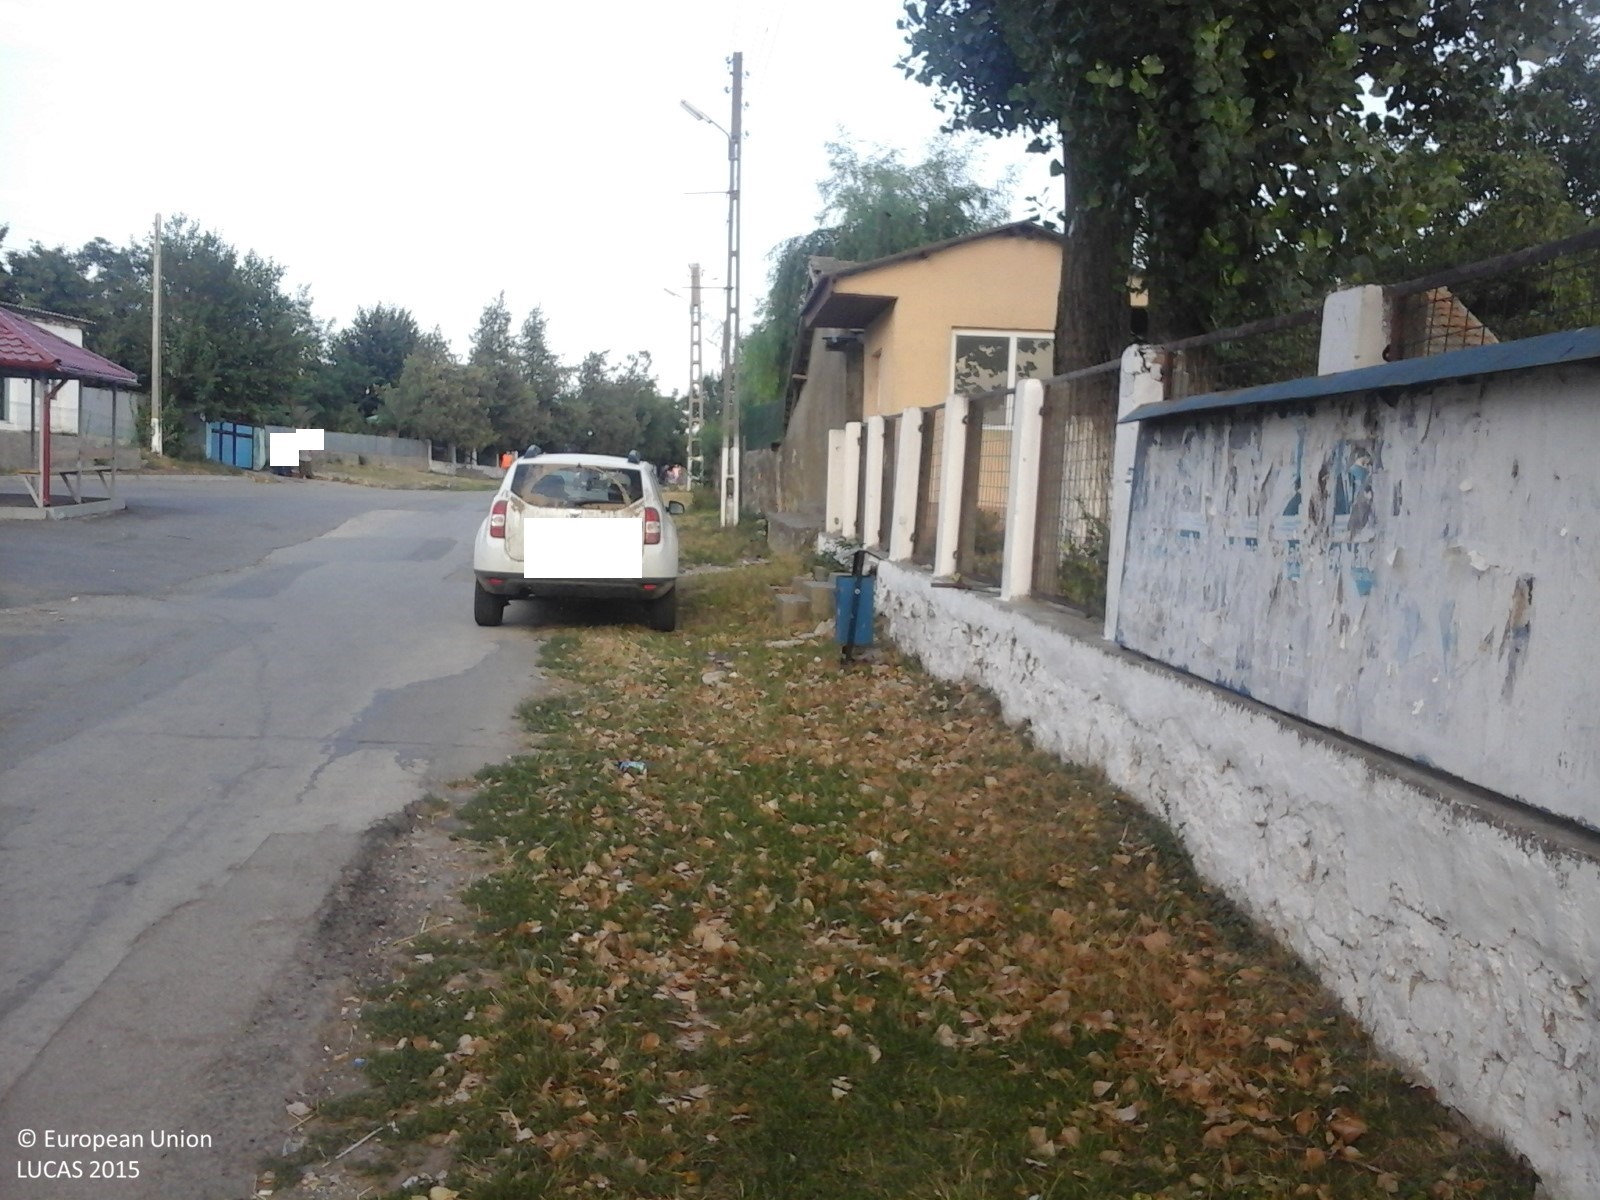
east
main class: Grassland
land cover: Grassland with sparse tree/shrub cover
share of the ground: > 75 %
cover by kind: herbaceous plants 85 %, shrubs 10 %, broadleaved forest trees 5 %
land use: Community services
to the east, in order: Grassland with sparse tree/shrub cover; Artificial constructions in urban areas
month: August
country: RO
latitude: 44.3719
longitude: 28.0666
